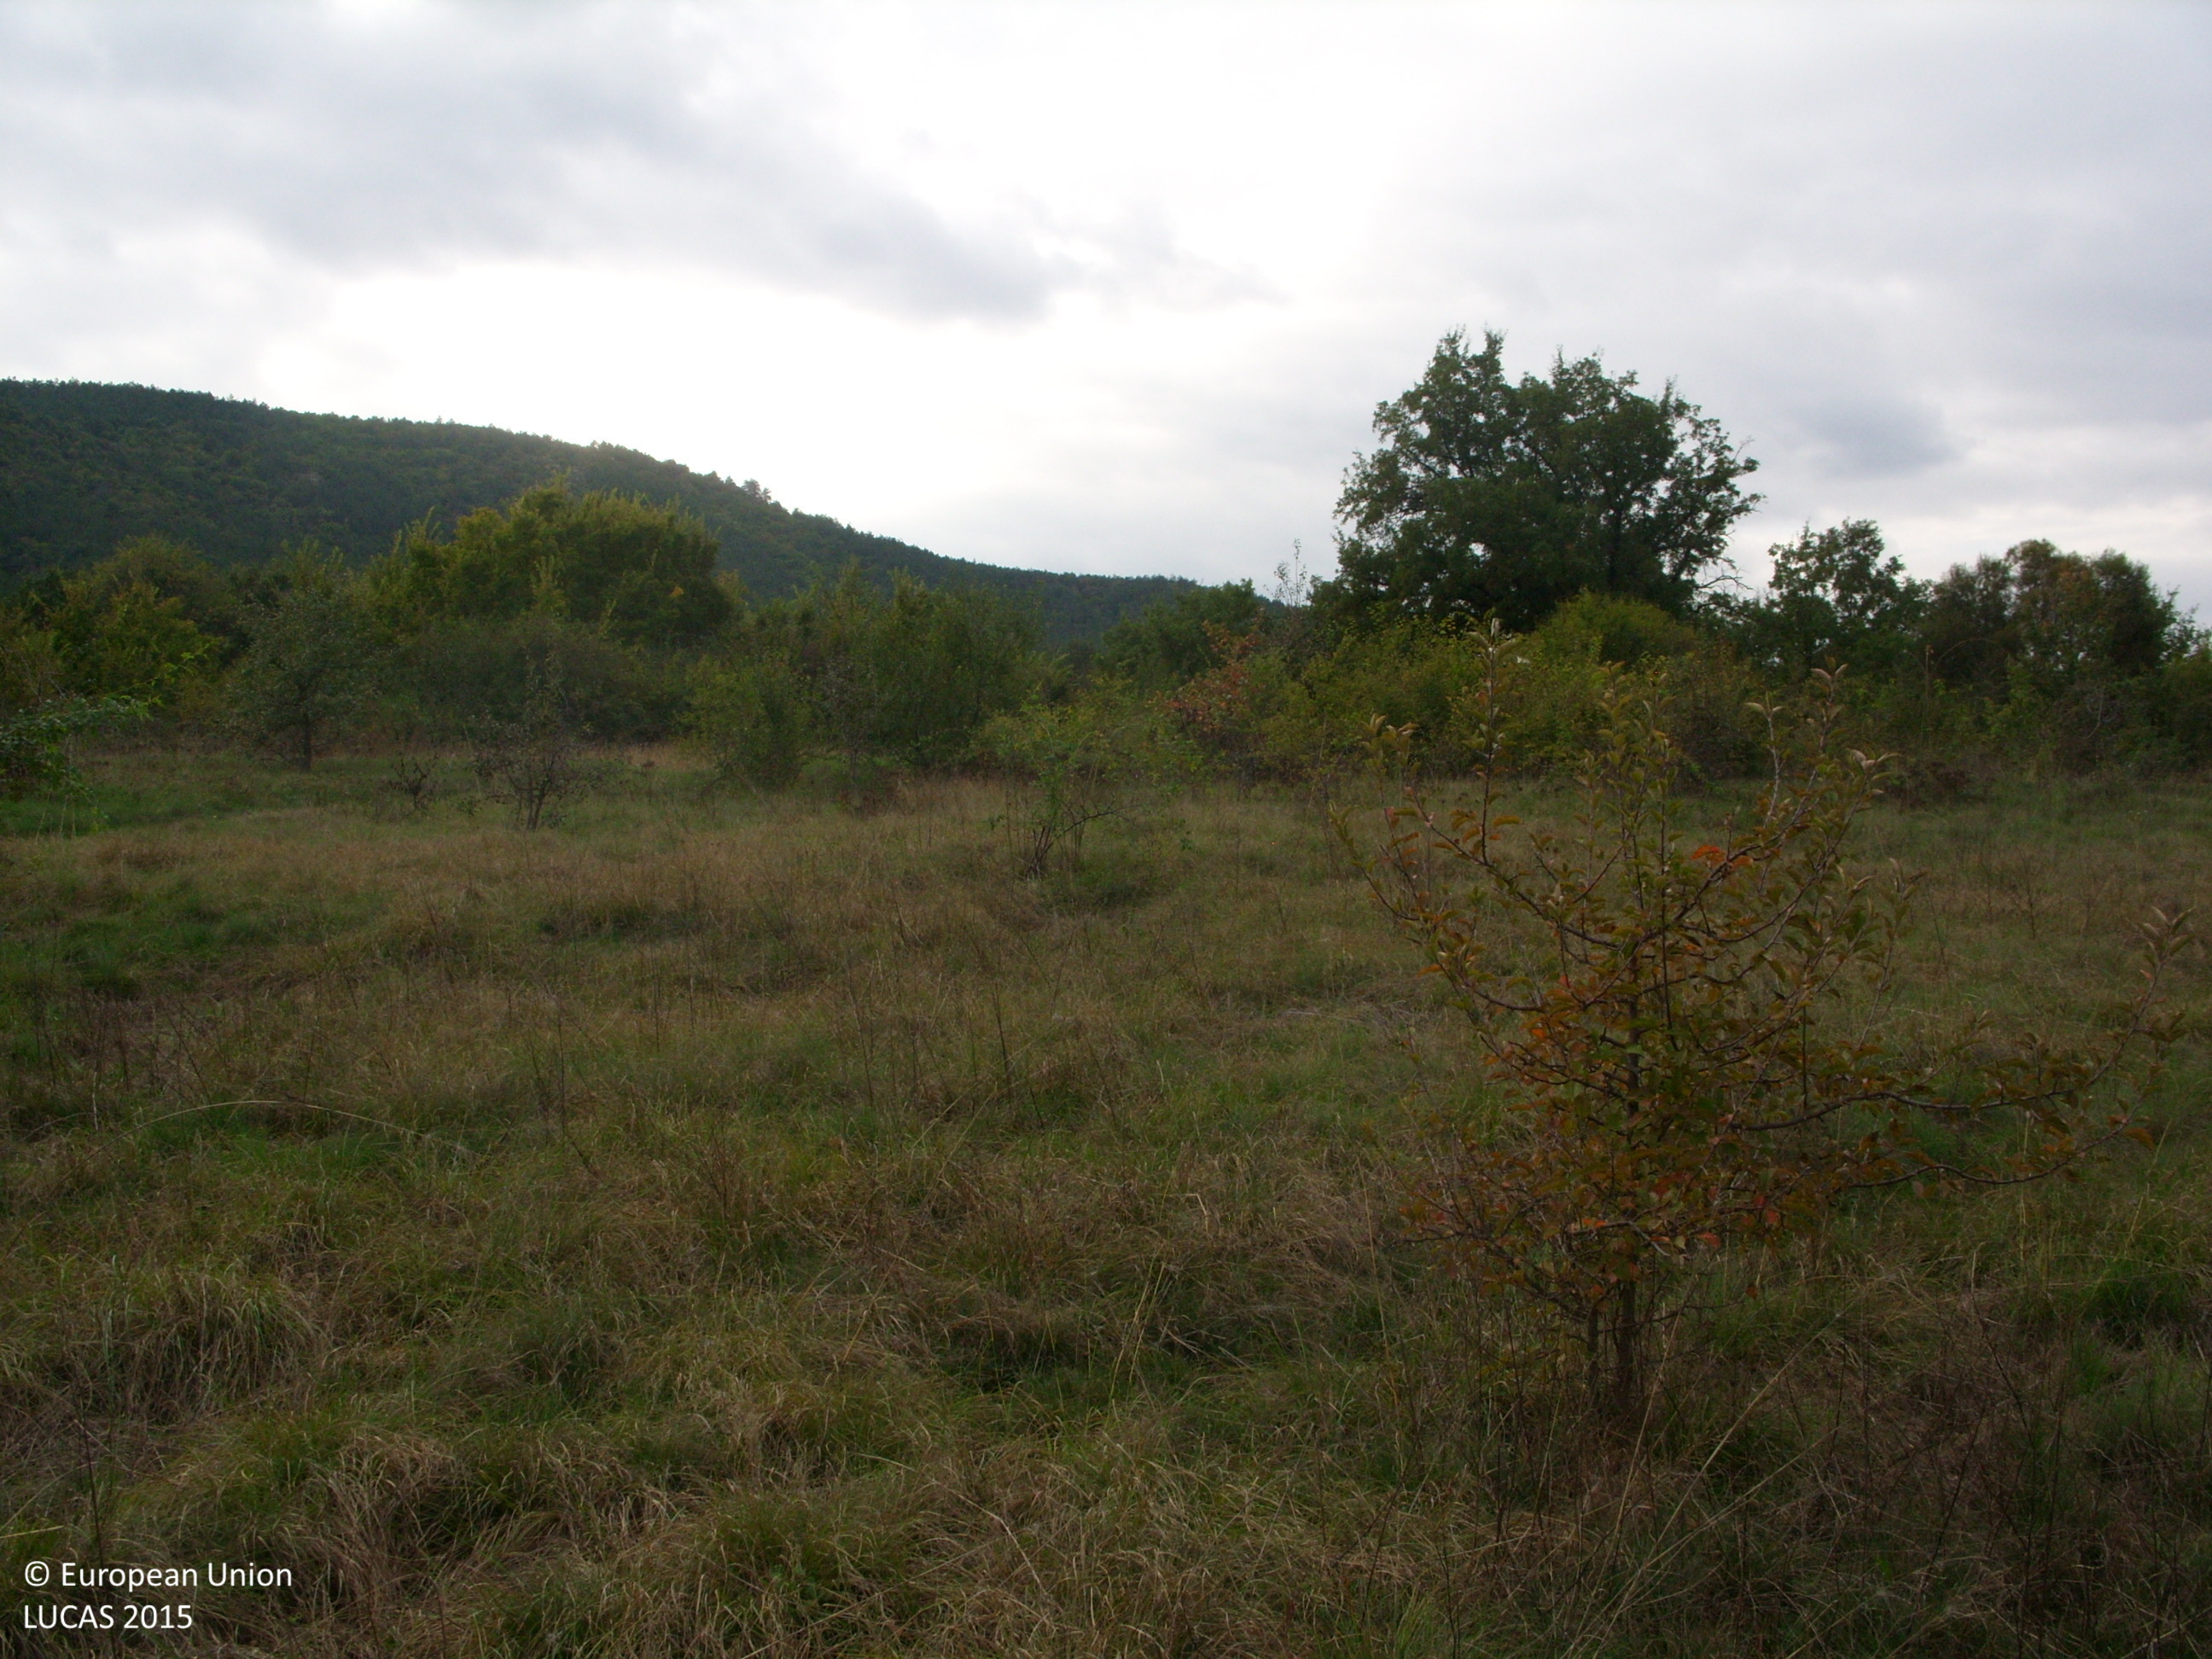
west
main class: Grassland
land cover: Grassland with sparse tree/shrub cover
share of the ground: > 75 %
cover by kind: herbaceous plants 90 %, broadleaved forest trees 5 %, shrubs 5 %
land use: Agriculture (excluding fallow land and kitchen gardens)
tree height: < 5 m
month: October
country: BG
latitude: 42.5489
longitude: 24.8047
